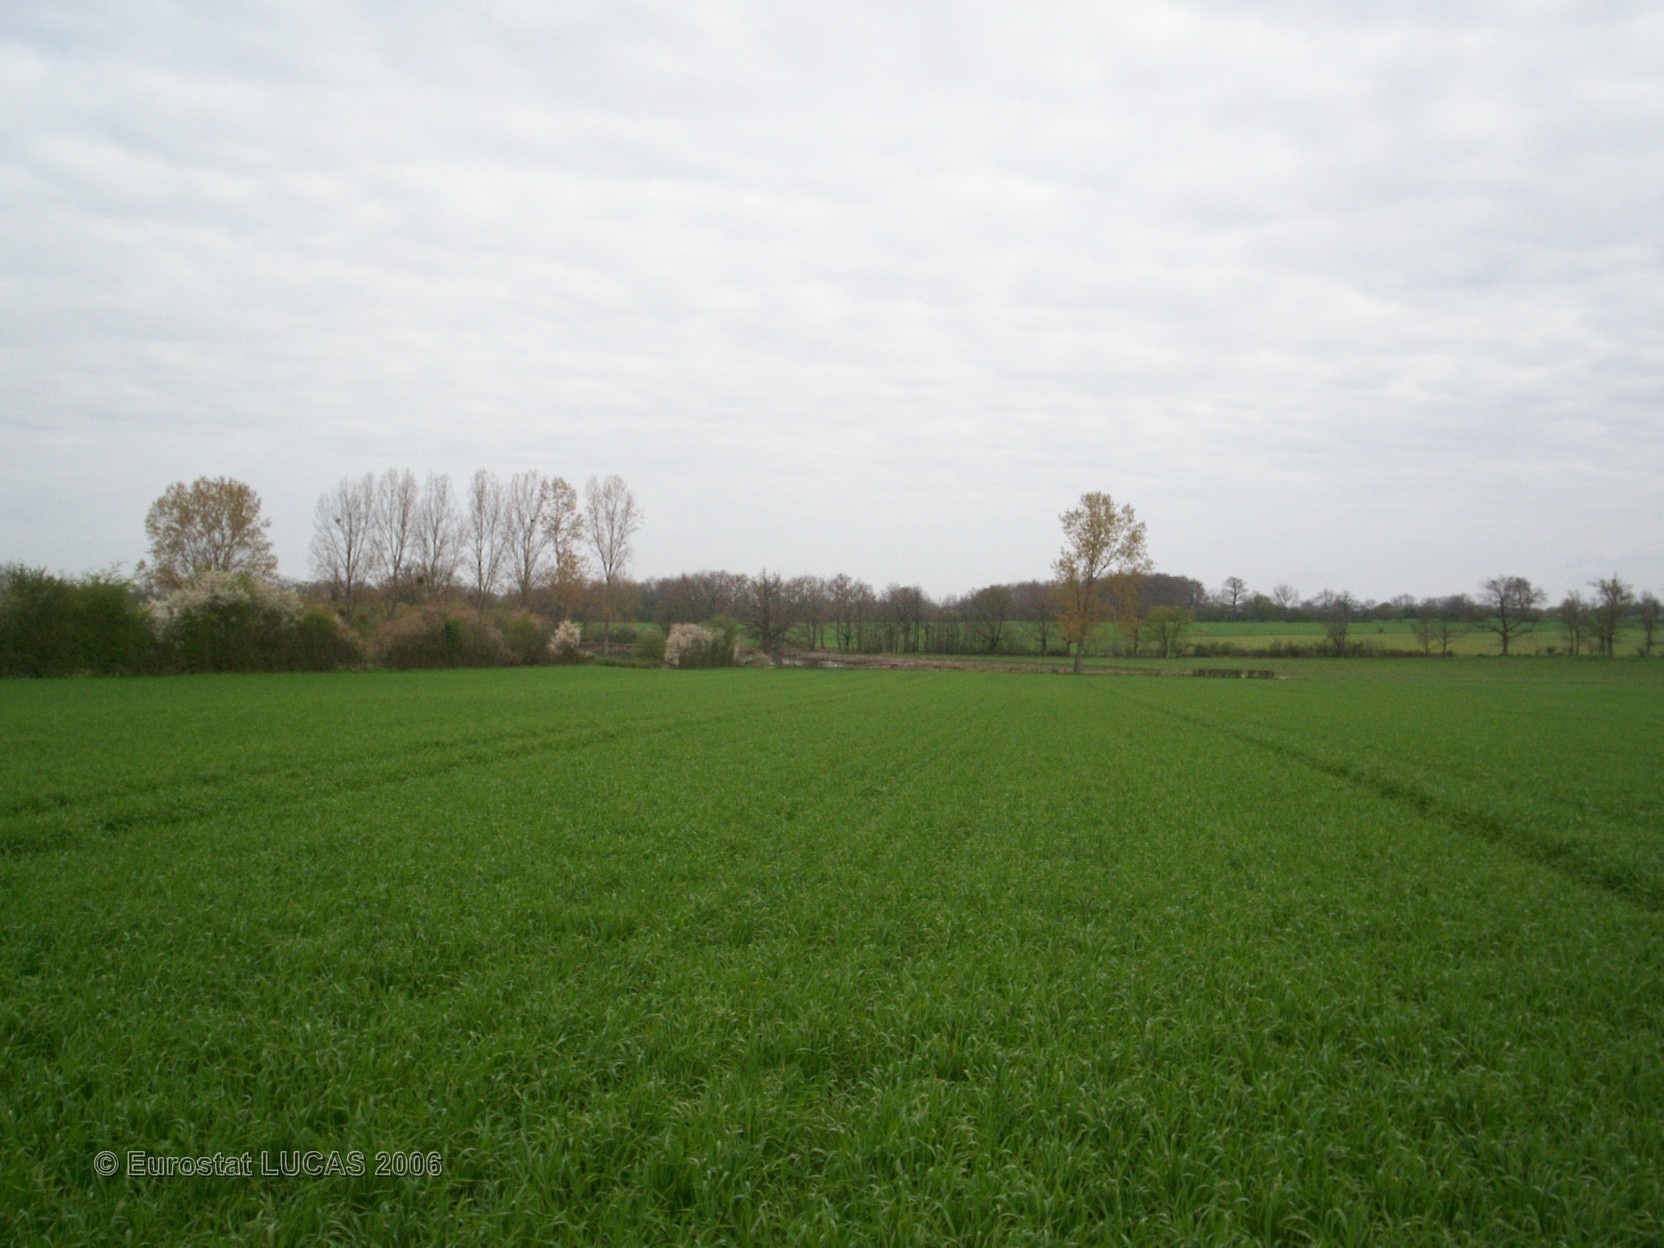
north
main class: Cropland
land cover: Barley
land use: Agriculture (excluding fallow land and kitchen gardens)
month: April
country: FR
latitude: 46.1492
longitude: 0.5459
